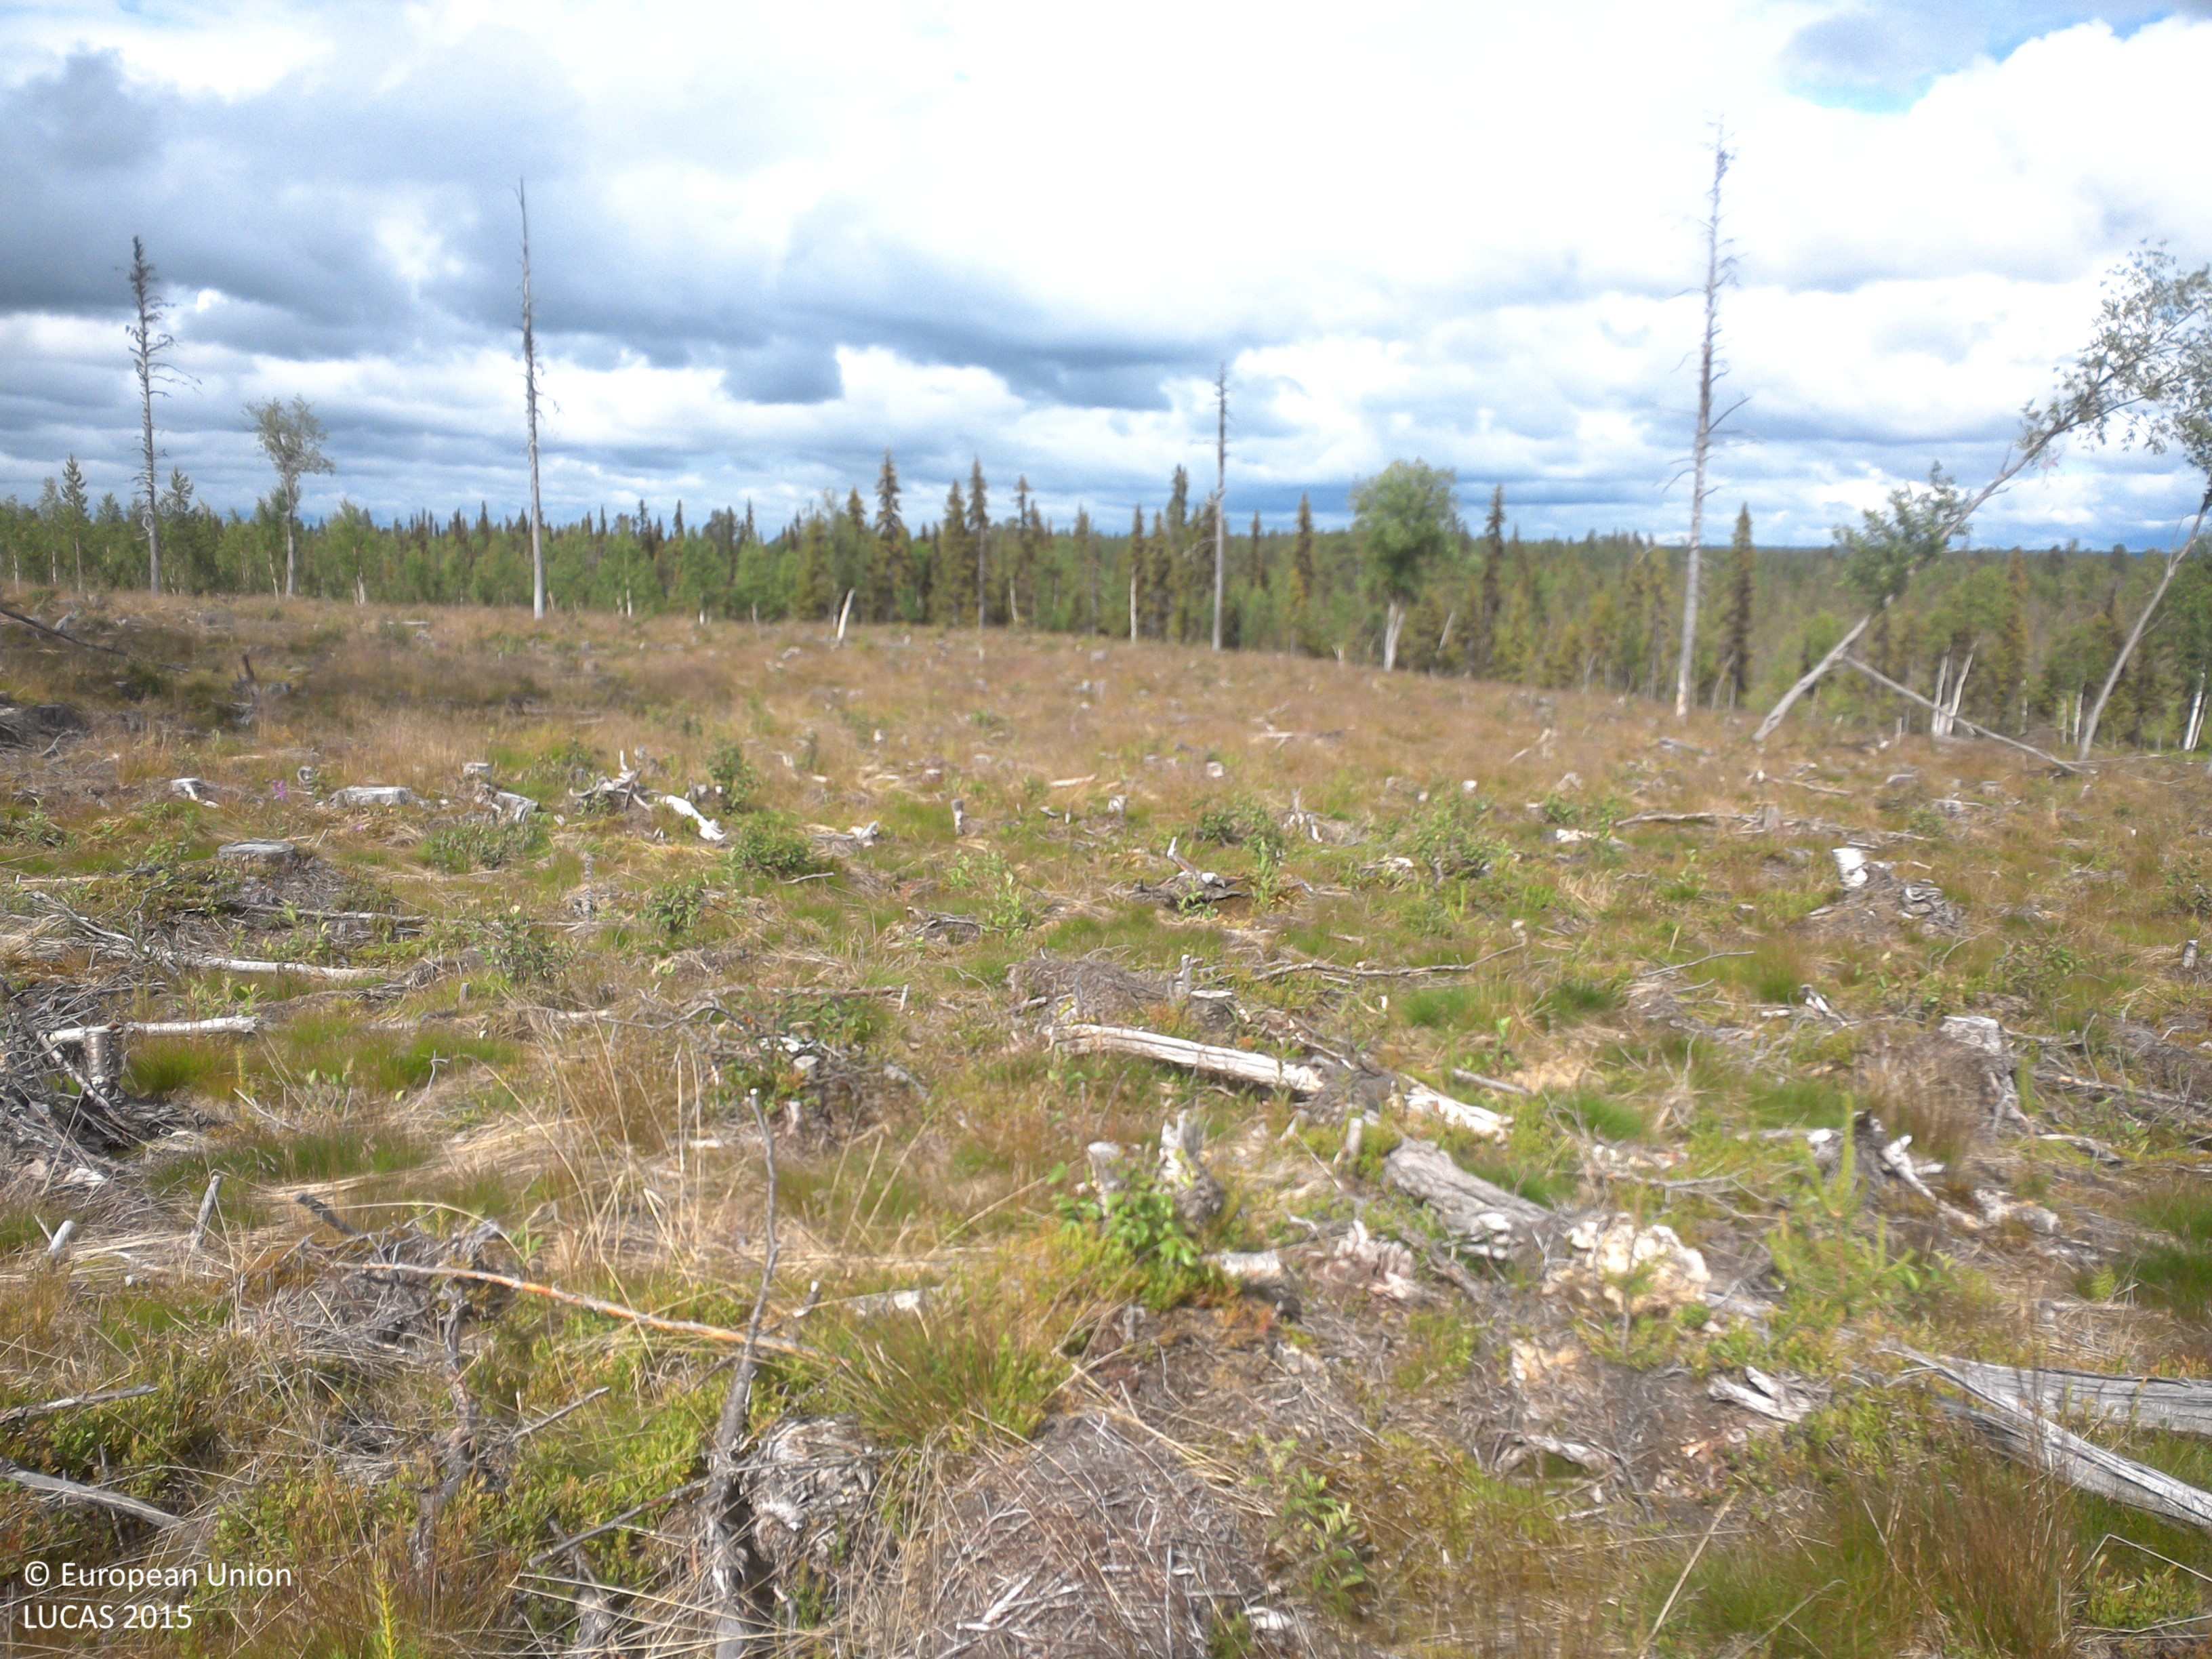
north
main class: Shrubland
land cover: Shrubland with sparse tree cover
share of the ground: 10 - 25 %
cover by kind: herbaceous plants 75 %, shrubs 10 %, unconsolidated bare surface 10 %, broadleaved forest trees 5 %
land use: Forestry
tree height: < 5 m
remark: Clear cut
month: July
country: SE
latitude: 67.5009
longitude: 22.2495
